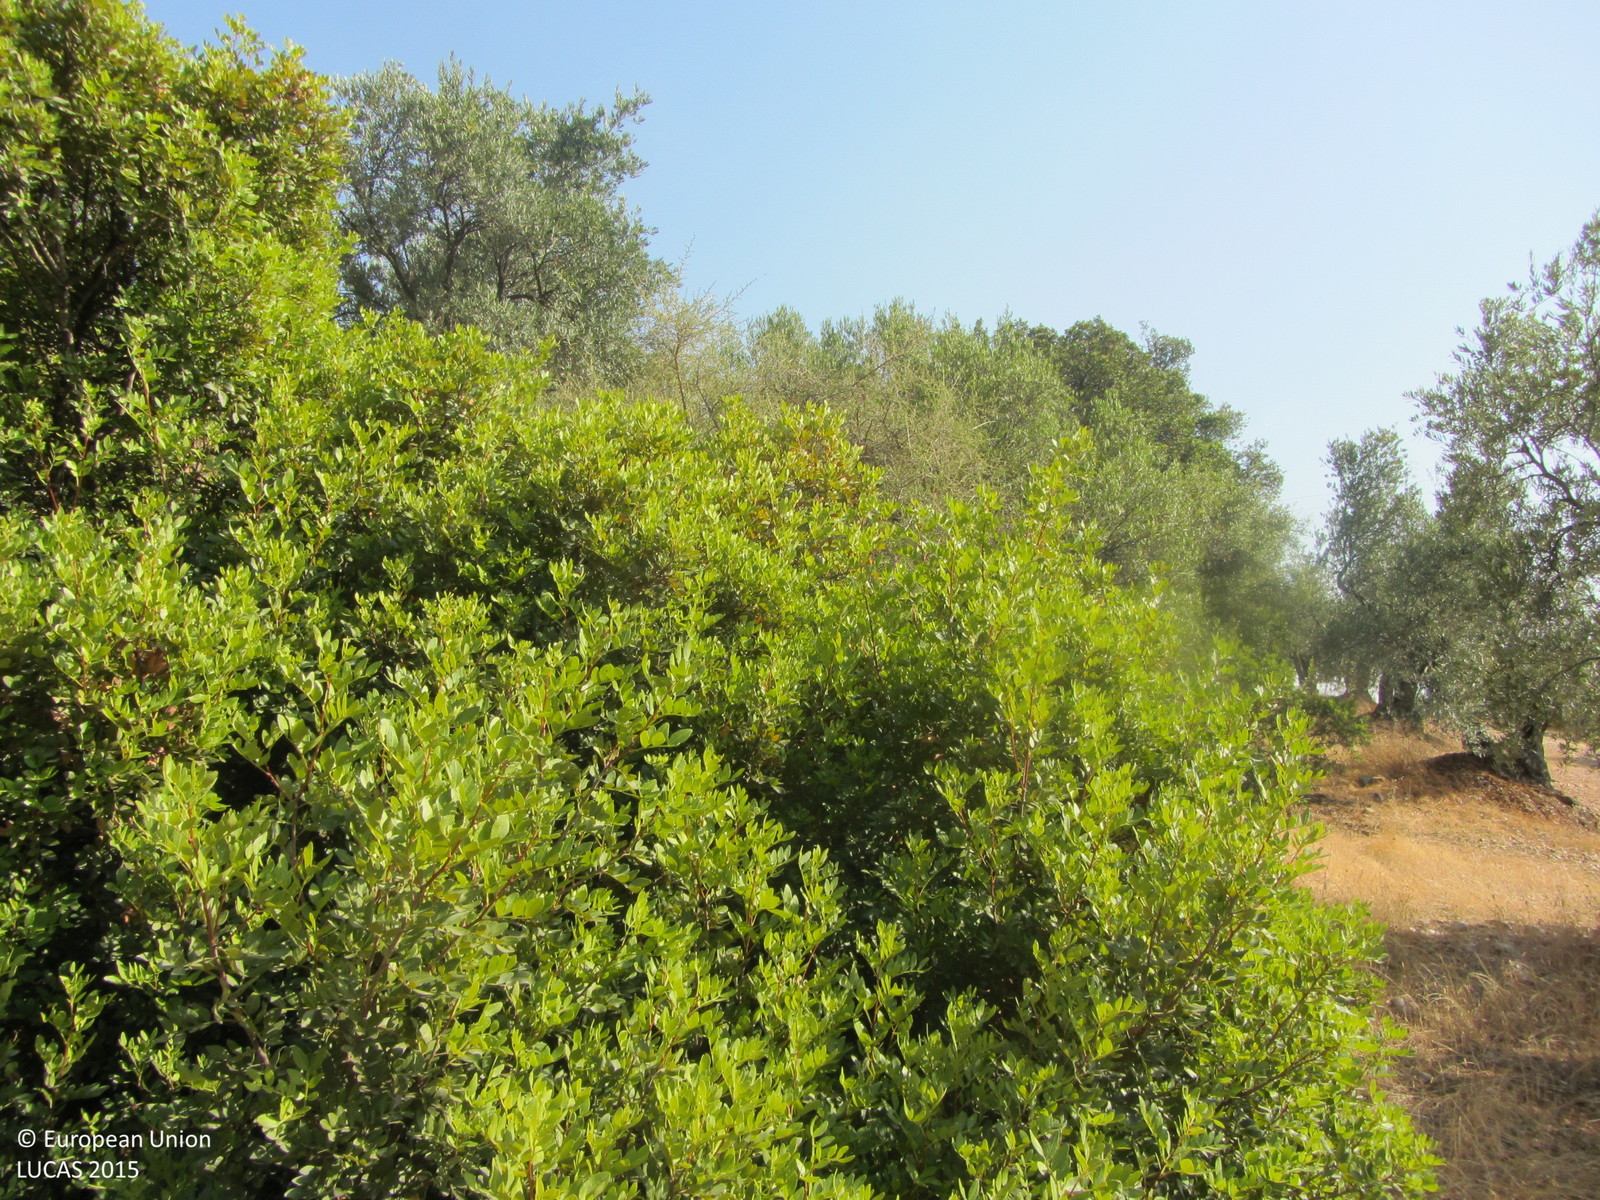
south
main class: Cropland
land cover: Olive groves
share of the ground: 25 - 50 %
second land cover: Spontaneously vegetated surfaces
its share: 50 - 75 %
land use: Agriculture (excluding fallow land and kitchen gardens)
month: July
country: ES
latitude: 38.0506
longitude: -3.8515
